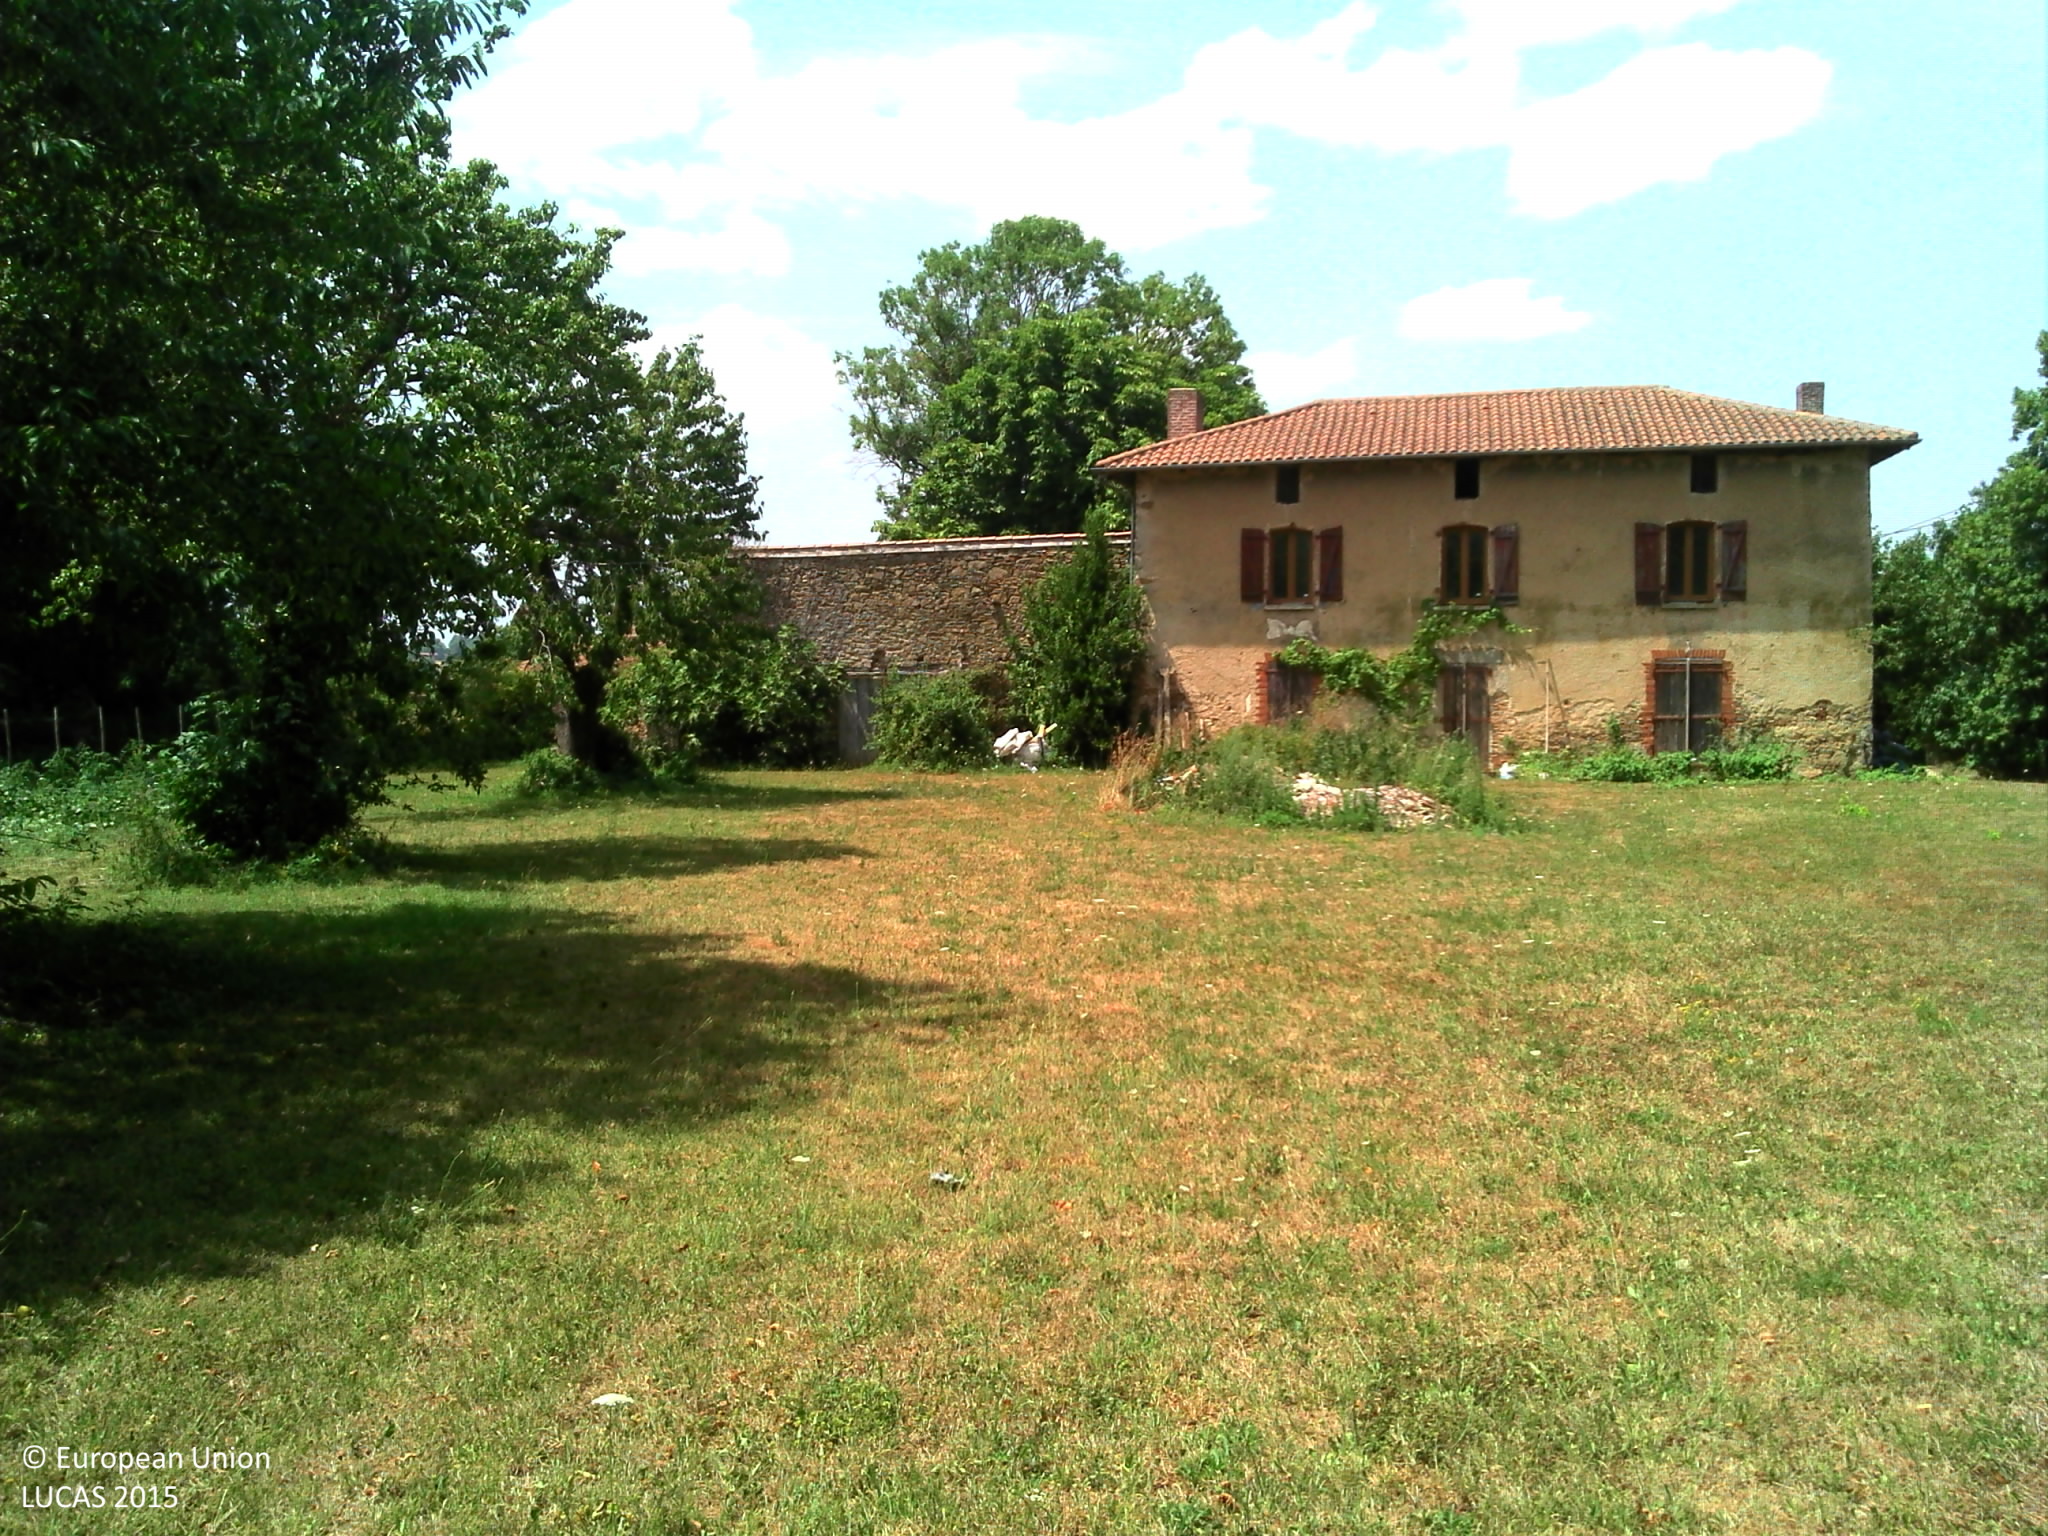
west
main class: Grassland
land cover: Grassland without tree/shrub cover
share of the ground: > 75 %
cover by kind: herbaceous plants 95 %
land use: Residential
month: July
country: FR
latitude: 45.7004
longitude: 1.0123
